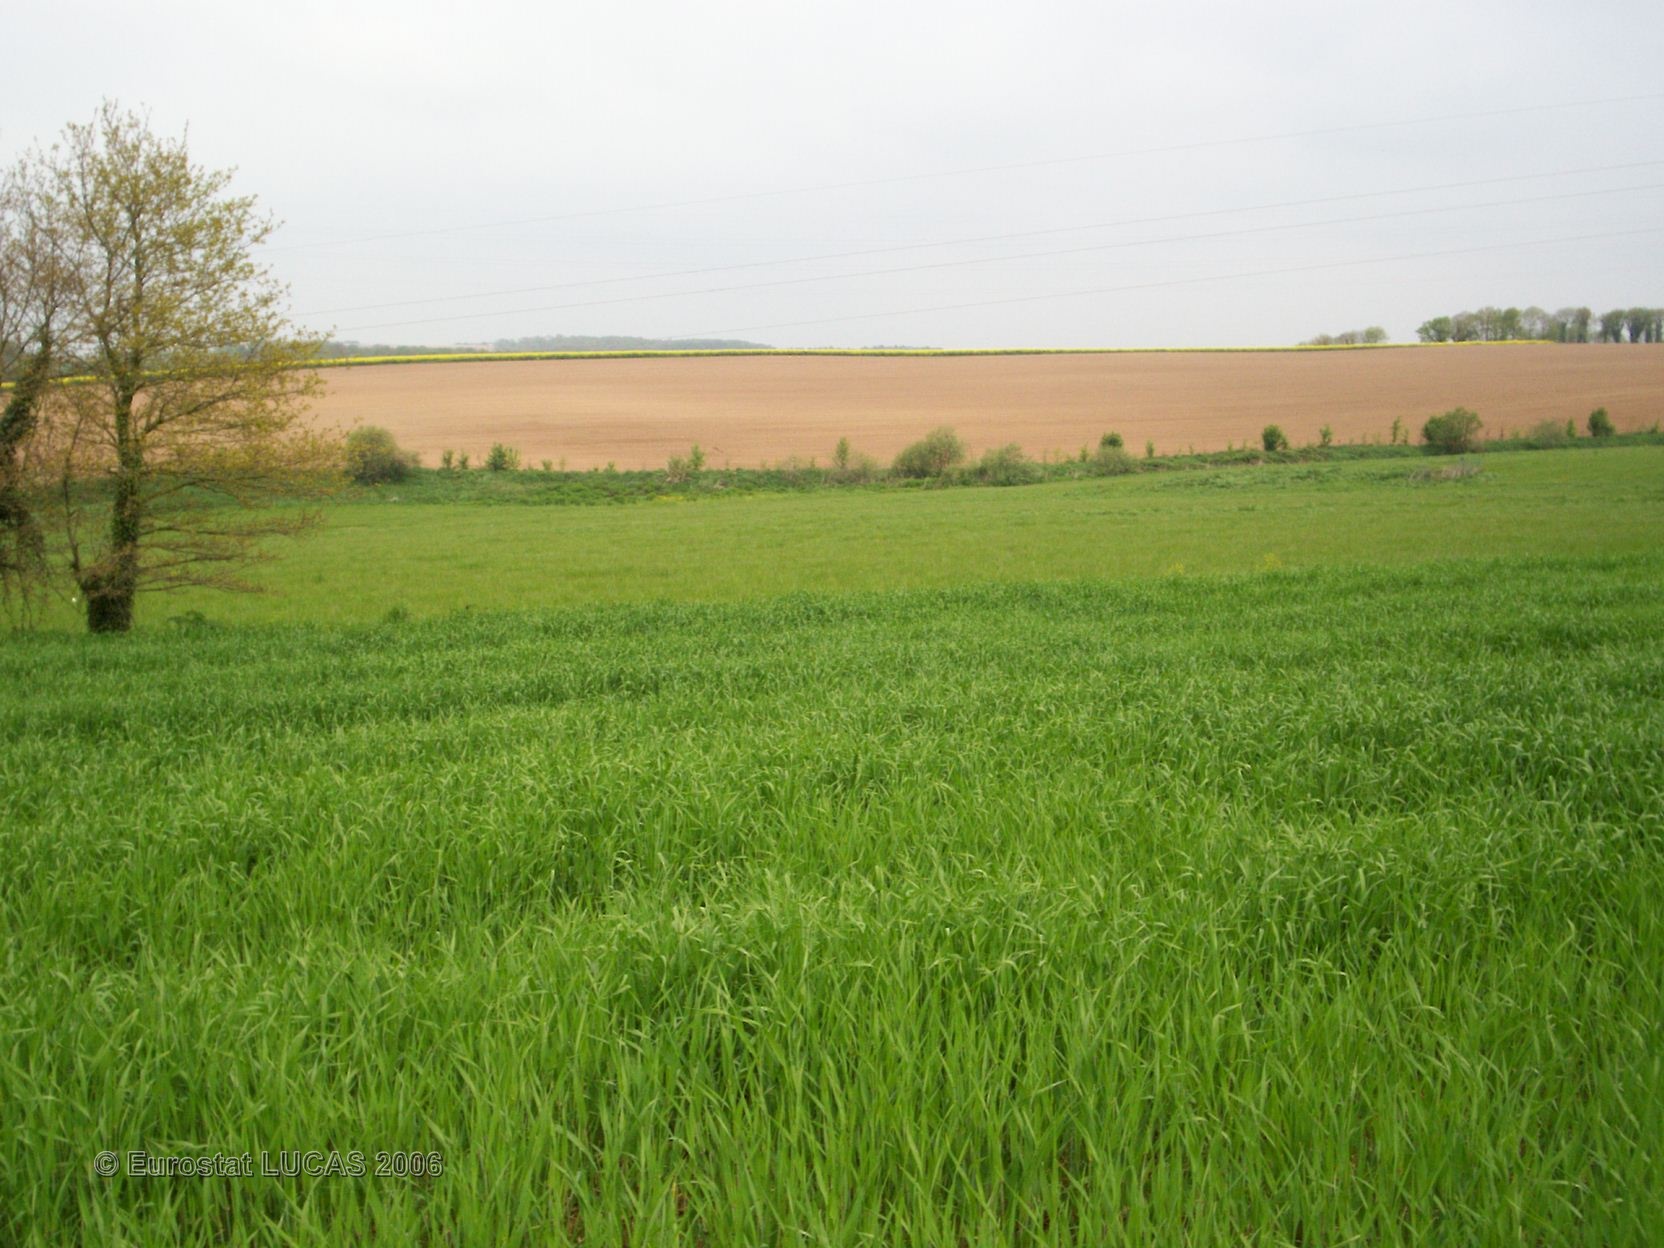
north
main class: Cropland
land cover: Barley
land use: Agriculture (excluding fallow land and kitchen gardens)
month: May
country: FR
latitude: 48.1661
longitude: -2.7982
